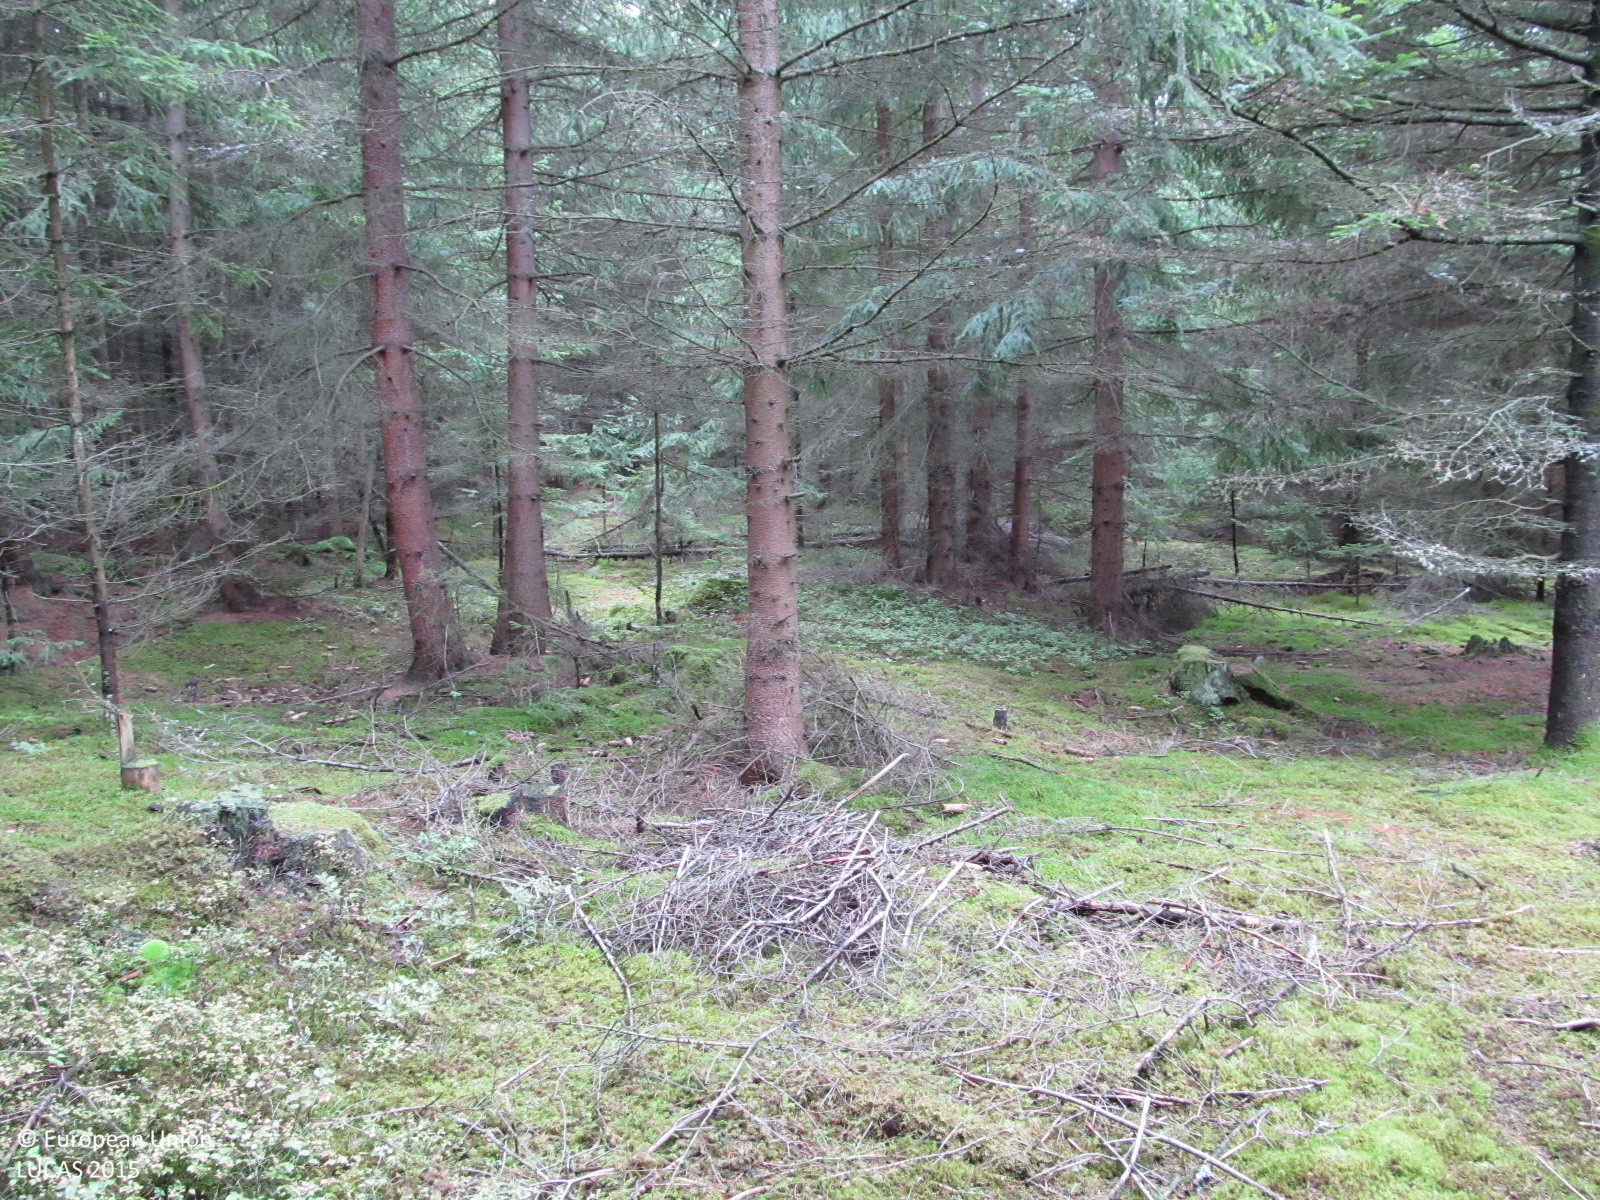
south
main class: Woodland
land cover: Spruce dominated coniferous woodland
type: hemiboreal forest and nemoral coniferous forest and mixed broadleaved-coniferous forest
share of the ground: > 75 %
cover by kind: coniferous forest trees 80 %, herbaceous plants 10 %, lichens and mosses 10 %
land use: Forestry
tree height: > 5 m
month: September
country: AT
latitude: 48.9761
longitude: 15.3723
